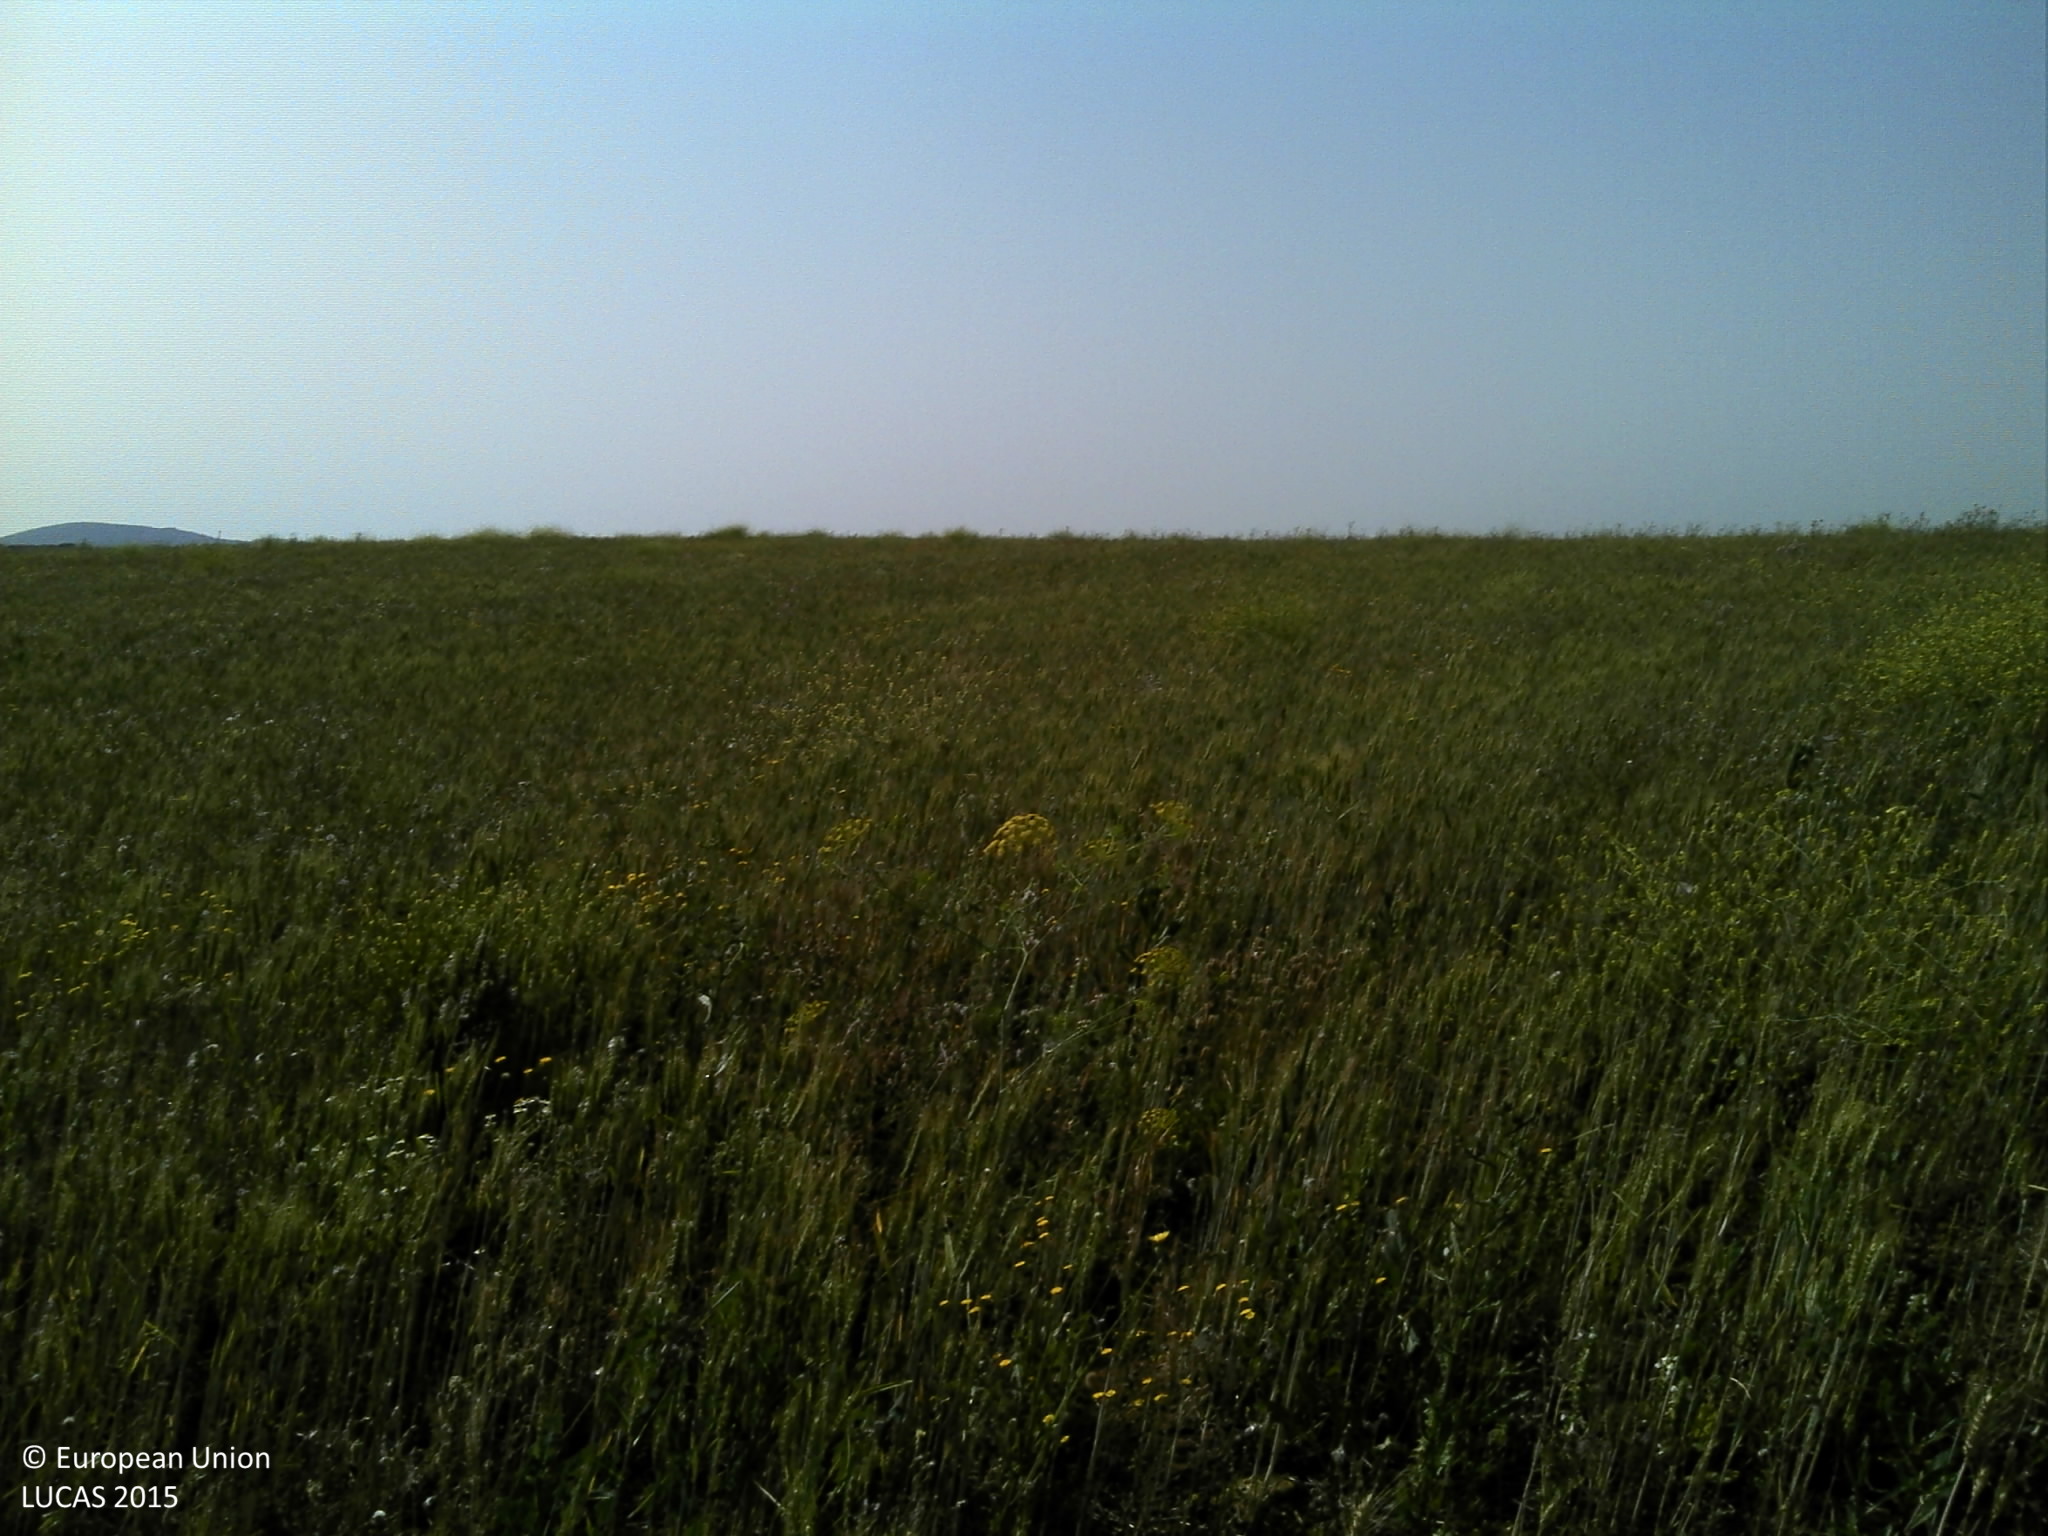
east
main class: Cropland
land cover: Mixed cereals for fodder
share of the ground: > 75 %
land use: Agriculture (excluding fallow land and kitchen gardens)
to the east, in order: Mixed cereals for fodder
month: May
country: PT
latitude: 38.9784
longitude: -7.7861
